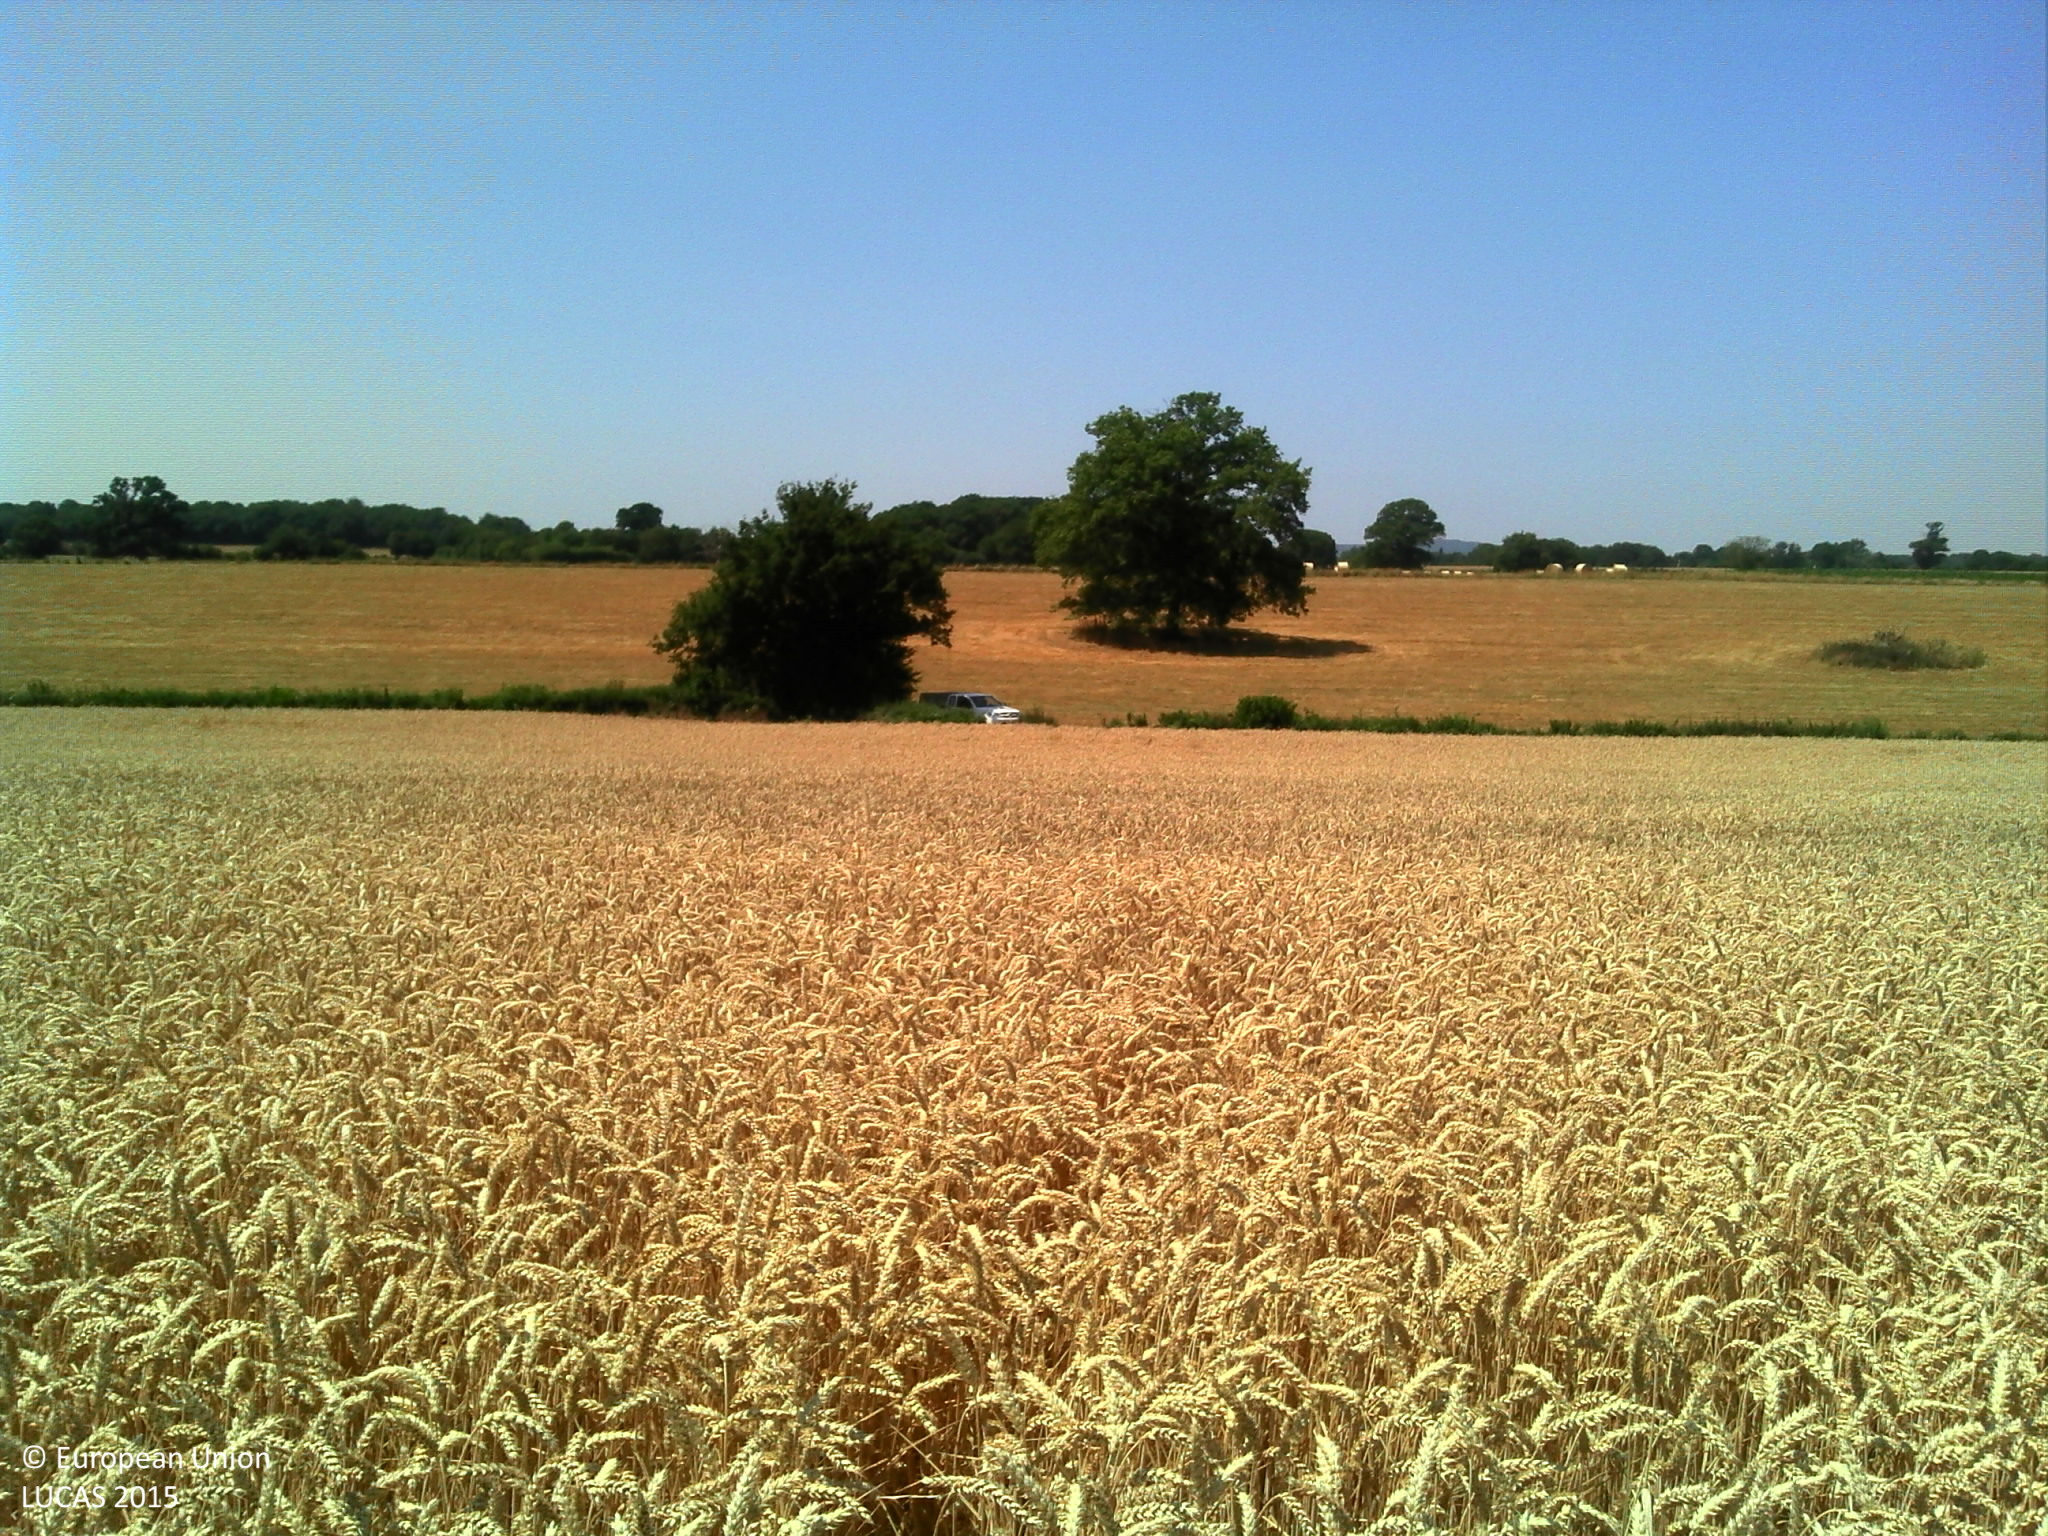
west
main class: Cropland
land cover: Common wheat
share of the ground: > 75 %
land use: Agriculture (excluding fallow land and kitchen gardens)
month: July
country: FR
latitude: 47.0259
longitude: 3.5900
